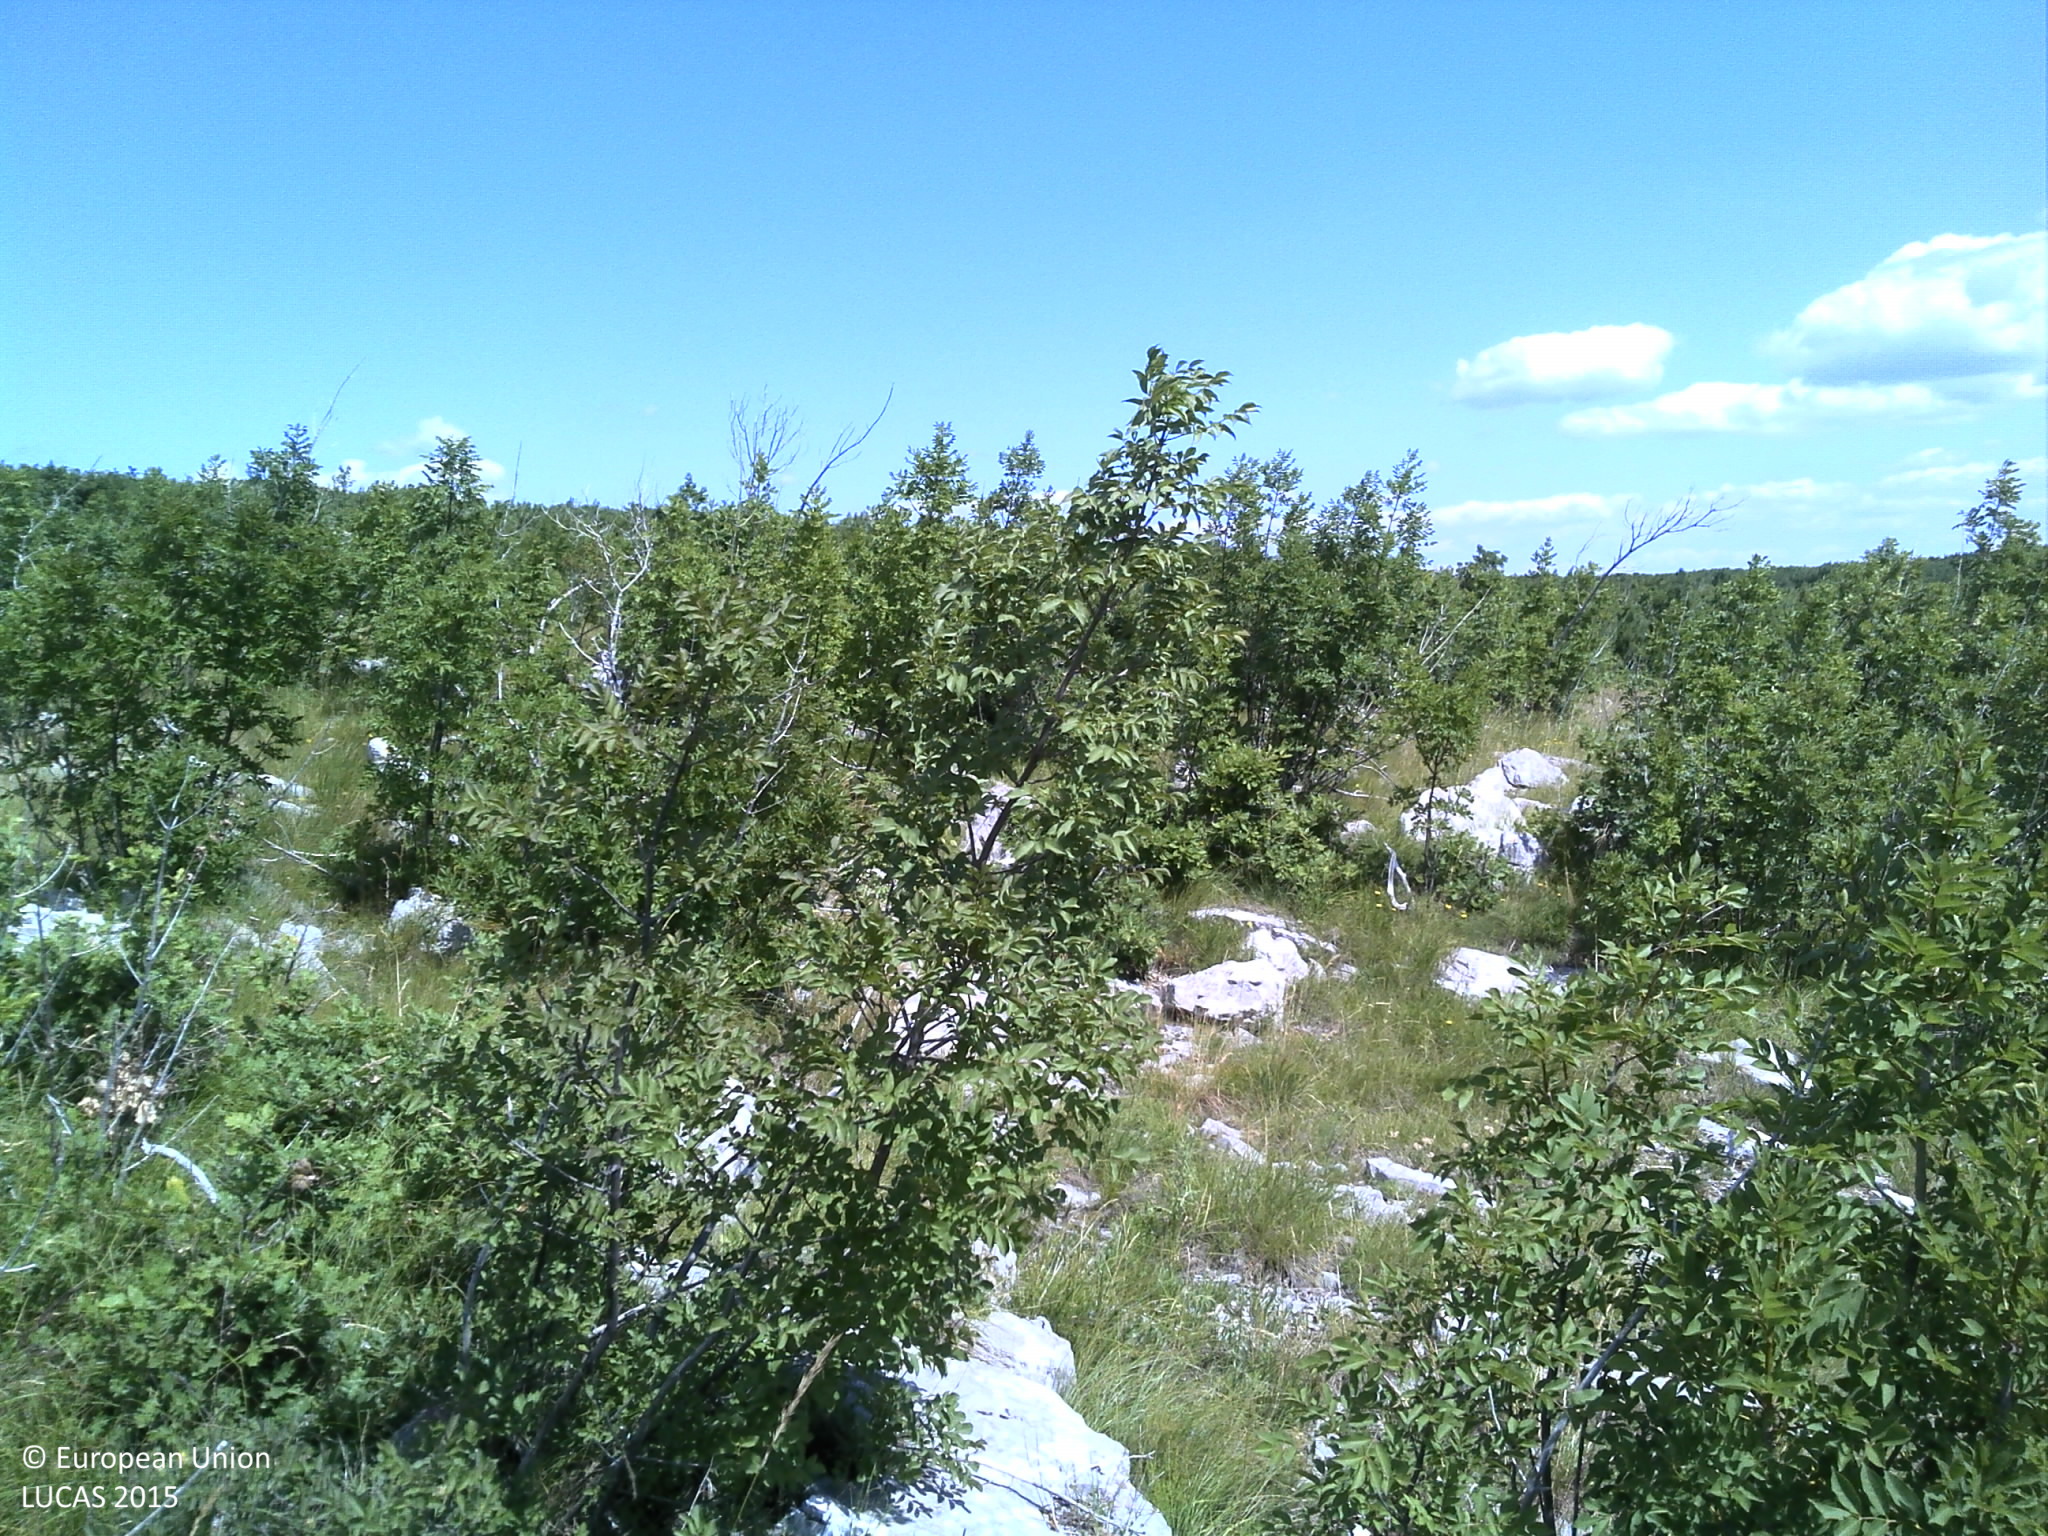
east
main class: Shrubland
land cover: Shrubland with sparse tree cover
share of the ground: > 75 %
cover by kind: shrubs 65 %, herbaceous plants 10 %, consolidated bare surface 10 %, unconsolidated bare surface 10 %, broadleaved forest trees 5 %
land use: Semi-natural and natural areas not in use
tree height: < 5 m
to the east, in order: Shrubland with sparse tree cover
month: June
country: HR
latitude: 43.6127
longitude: 16.9184
